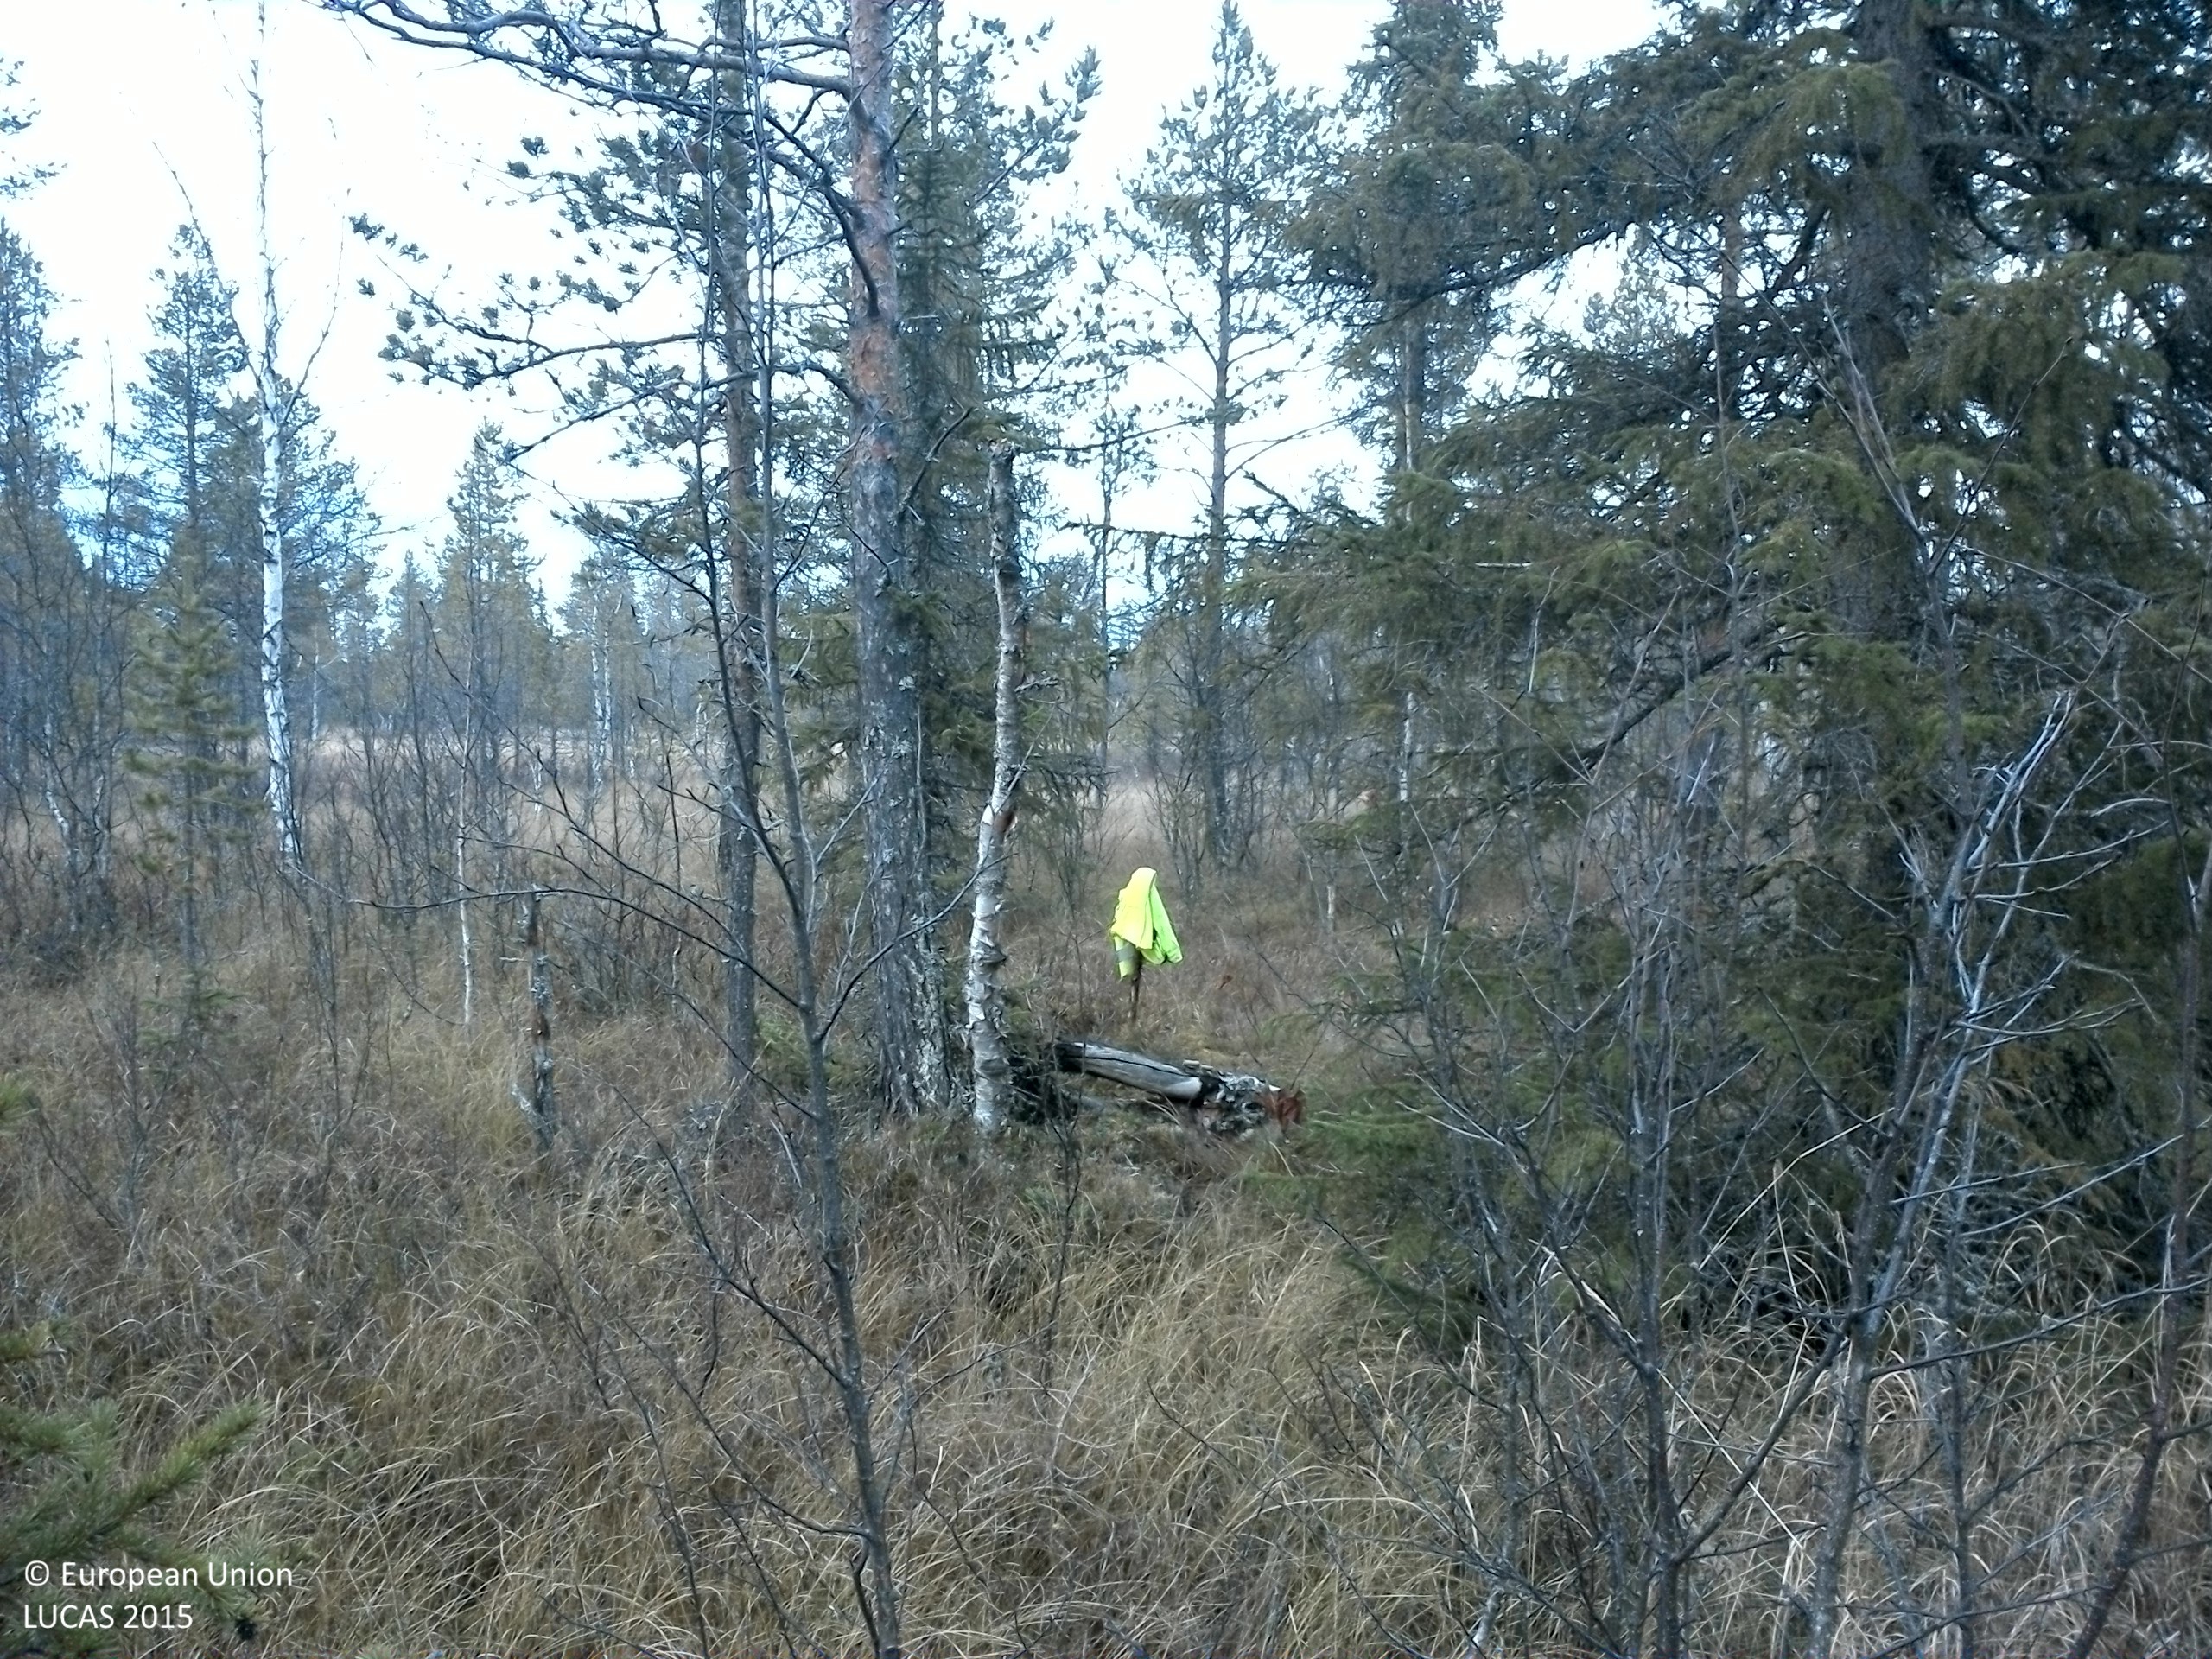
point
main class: Woodland
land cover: Pine dominated mixed woodland
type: mire and swamp forests
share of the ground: 25 - 50 %
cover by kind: coniferous forest trees 25 %, herbaceous plants 25 %, lichens and mosses 25 %, broadleaved forest trees 20 %, shrubs 5 %
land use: Forestry
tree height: > 5 m
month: October
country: SE
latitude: 63.7817
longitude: 15.3909
